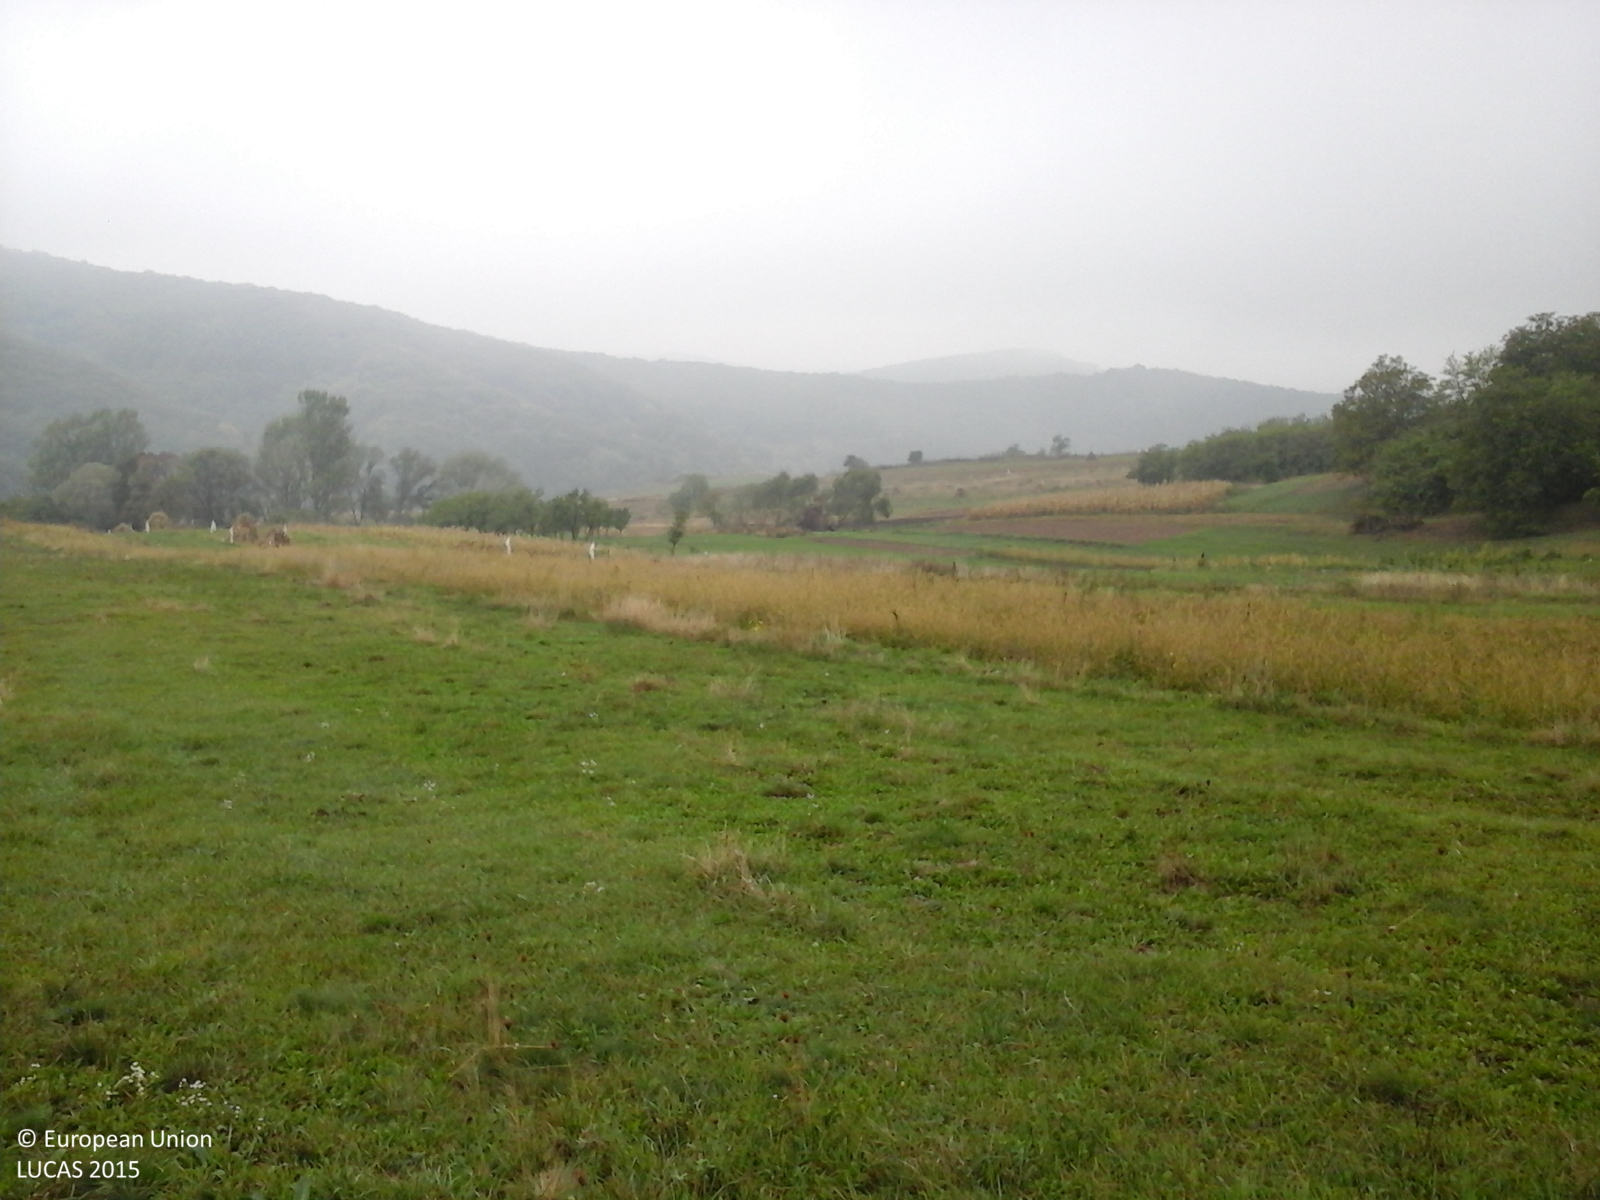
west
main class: Grassland
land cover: Grassland without tree/shrub cover
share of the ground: > 75 %
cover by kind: herbaceous plants 100 %
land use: Agriculture (excluding fallow land and kitchen gardens)
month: September
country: RO
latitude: 45.8648
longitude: 22.8438
